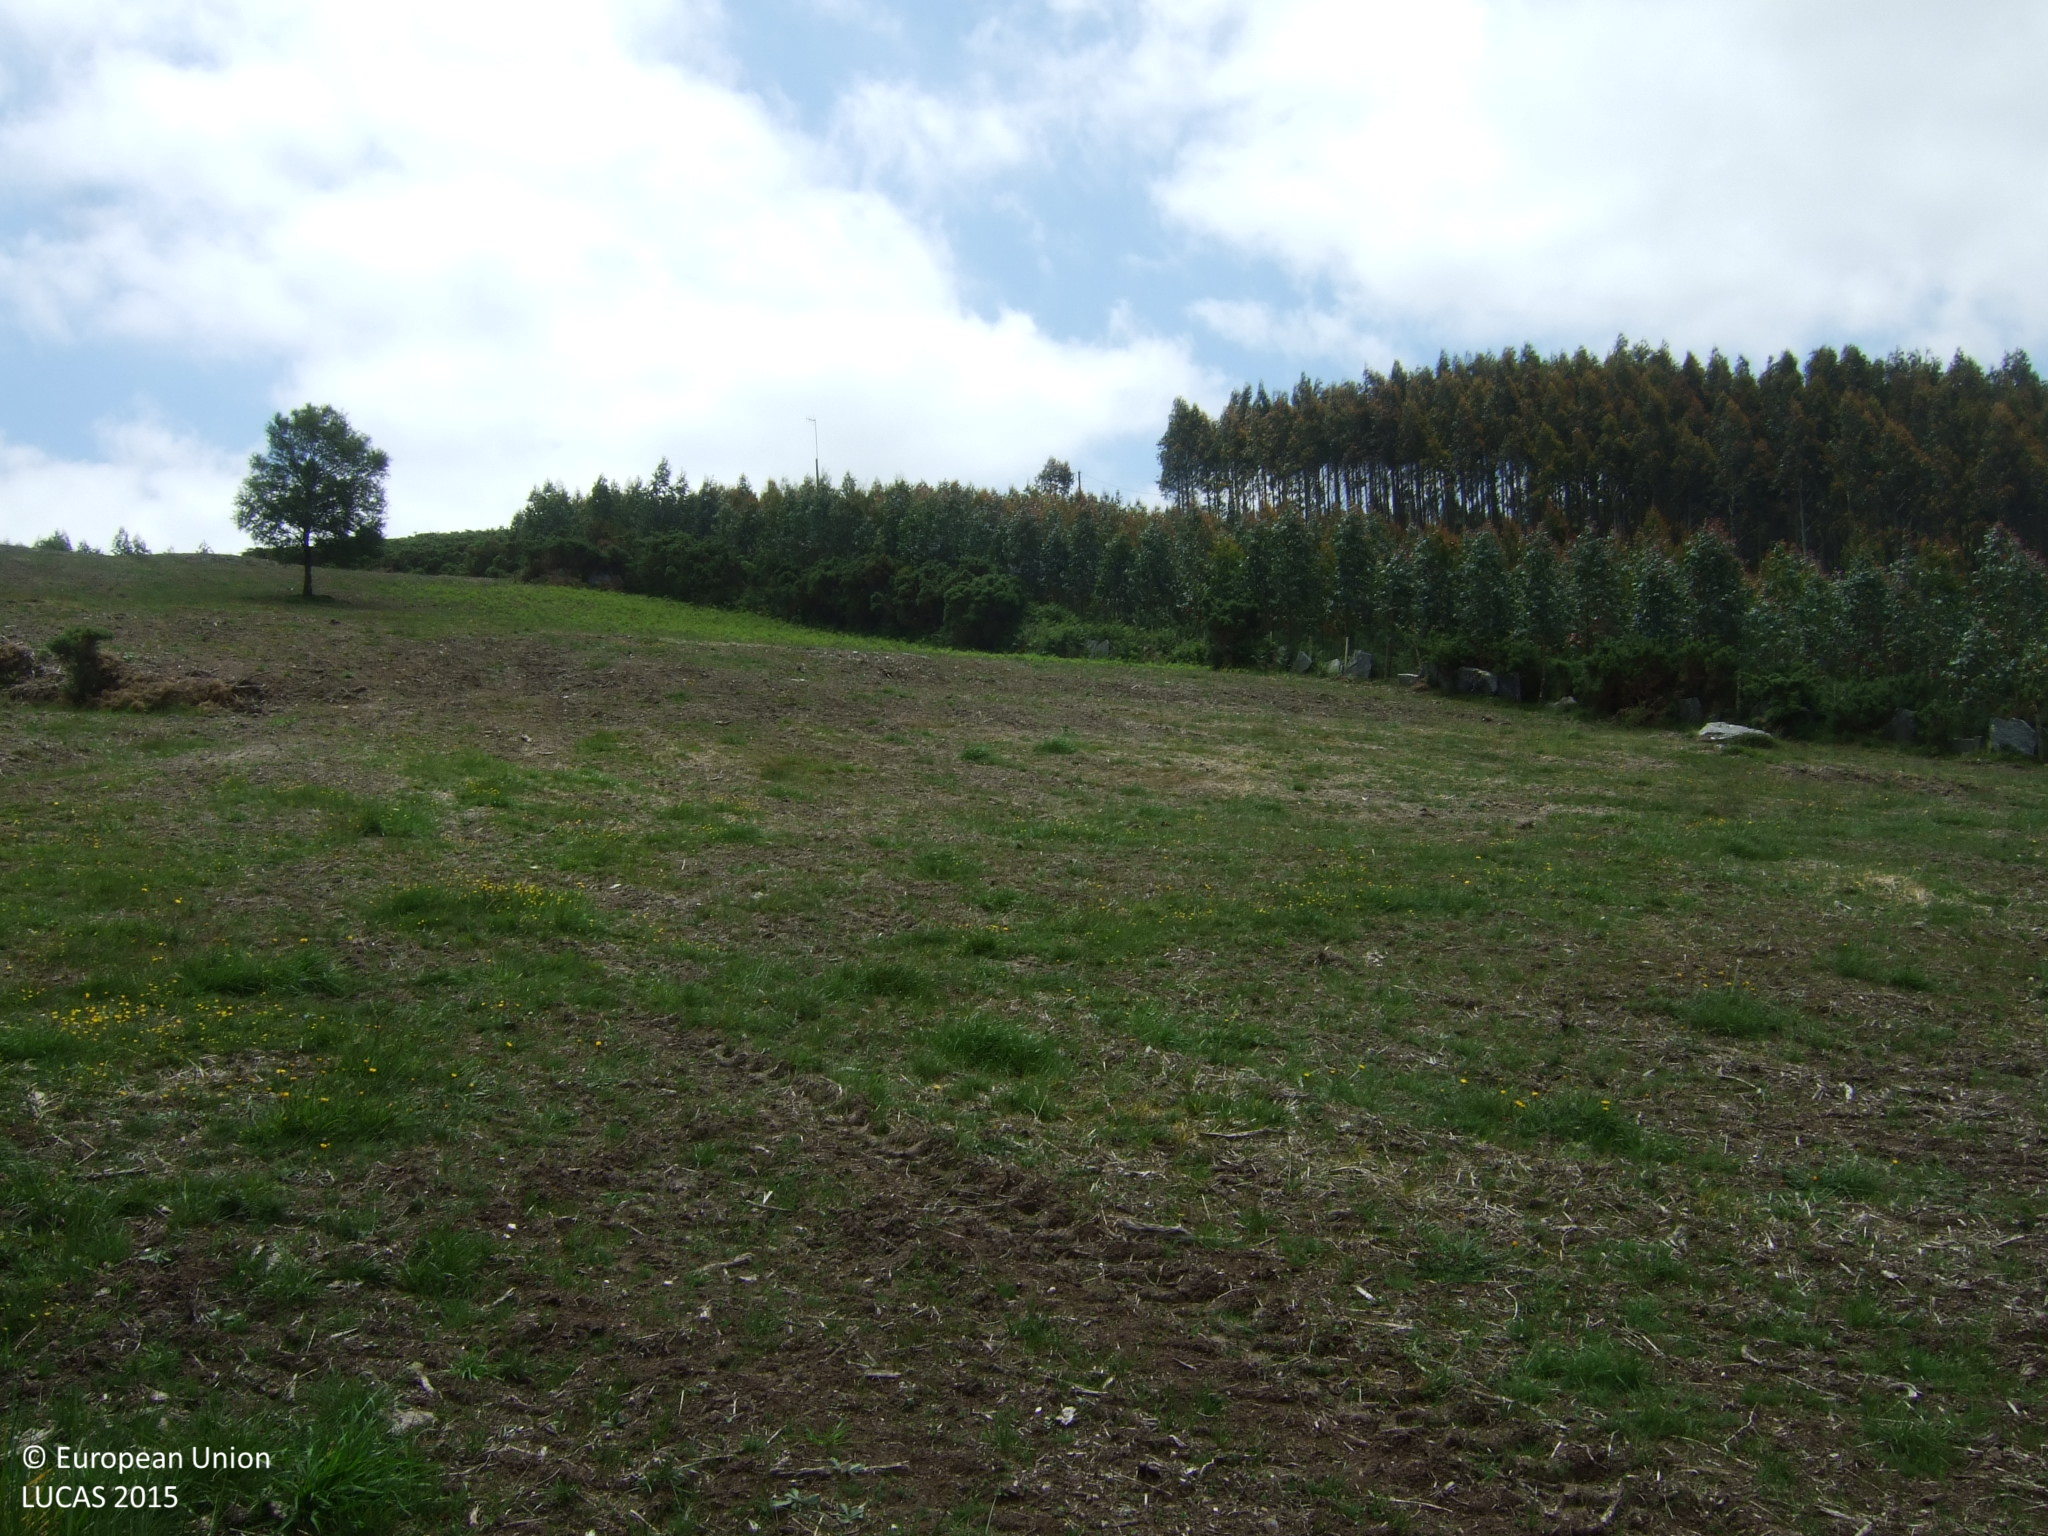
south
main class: Shrubland
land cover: Shrubland with sparse tree cover
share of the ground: > 75 %
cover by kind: shrubs 95 %, broadleaved forest trees 5 %
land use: Semi-natural and natural areas not in use
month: June
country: ES
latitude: 43.5298
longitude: -7.8225
